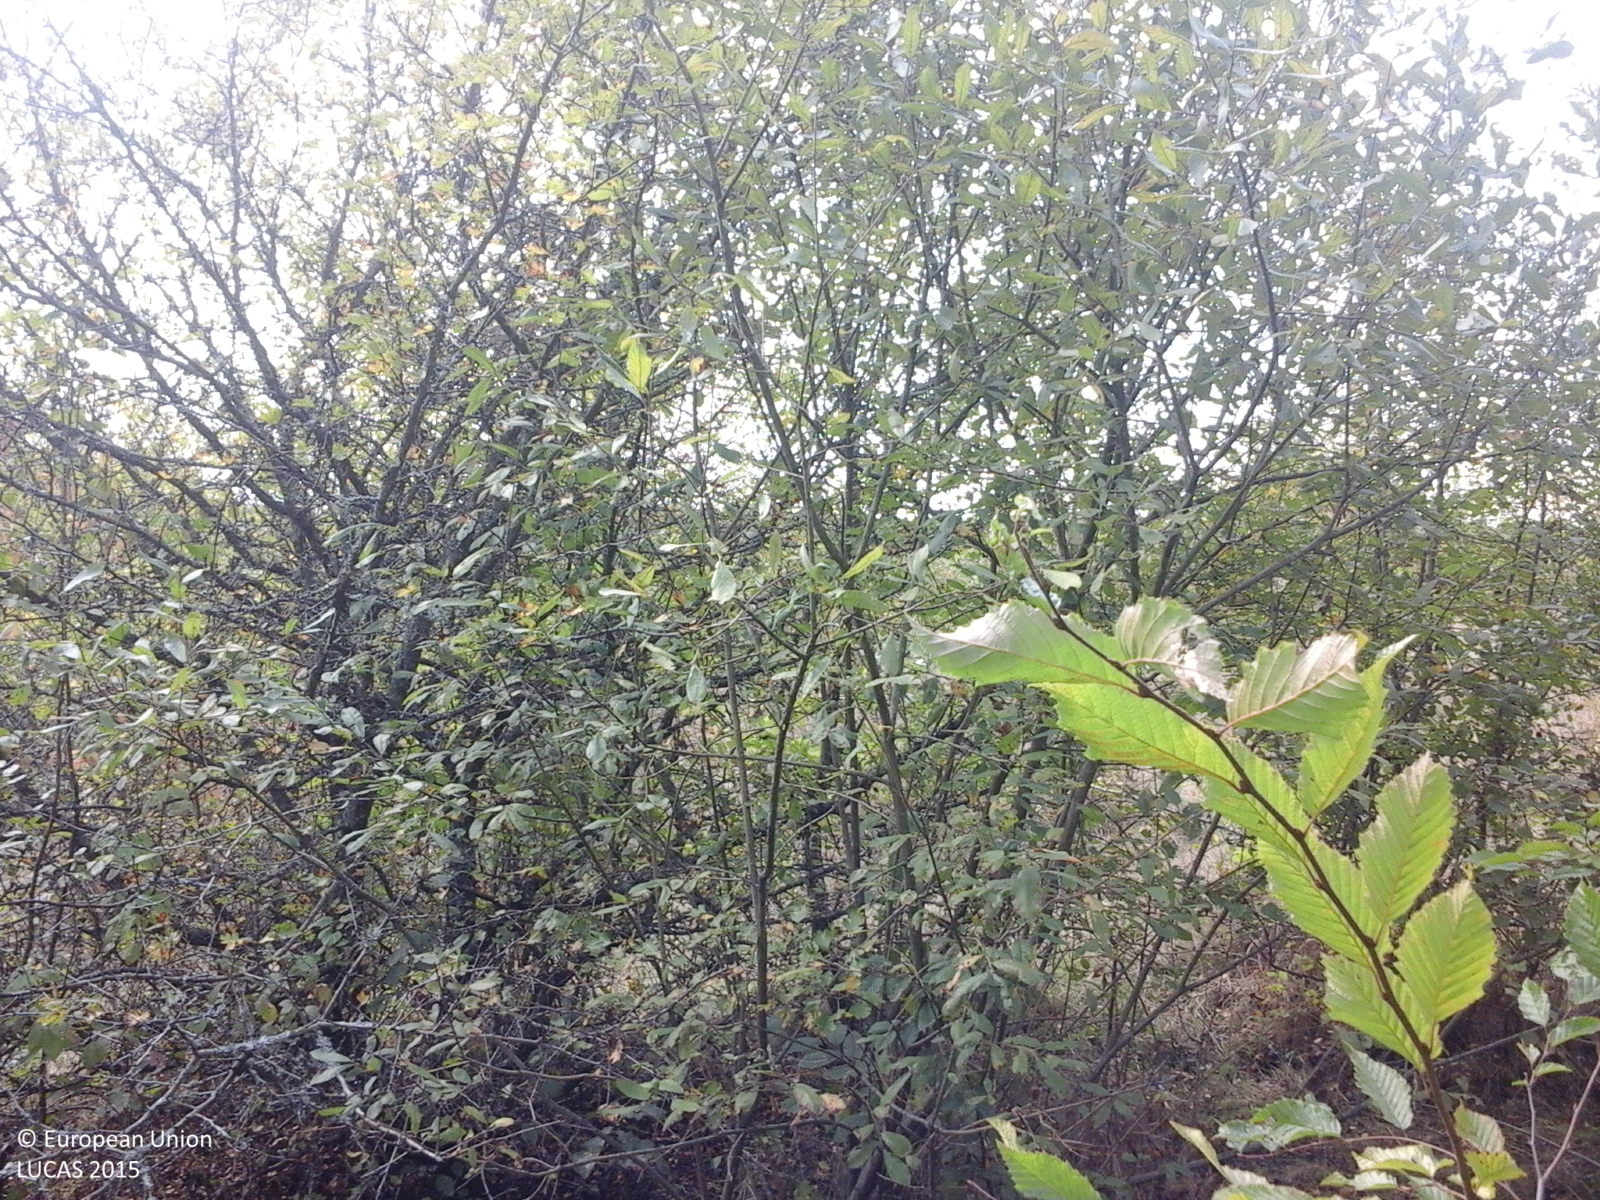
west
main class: Grassland
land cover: Grassland with sparse tree/shrub cover
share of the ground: > 75 %
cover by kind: herbaceous plants 85 %, shrubs 10 %, broadleaved forest trees 5 %
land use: Semi-natural and natural areas not in use
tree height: > 5 m
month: September
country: RO
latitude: 45.9462
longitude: 22.1564
